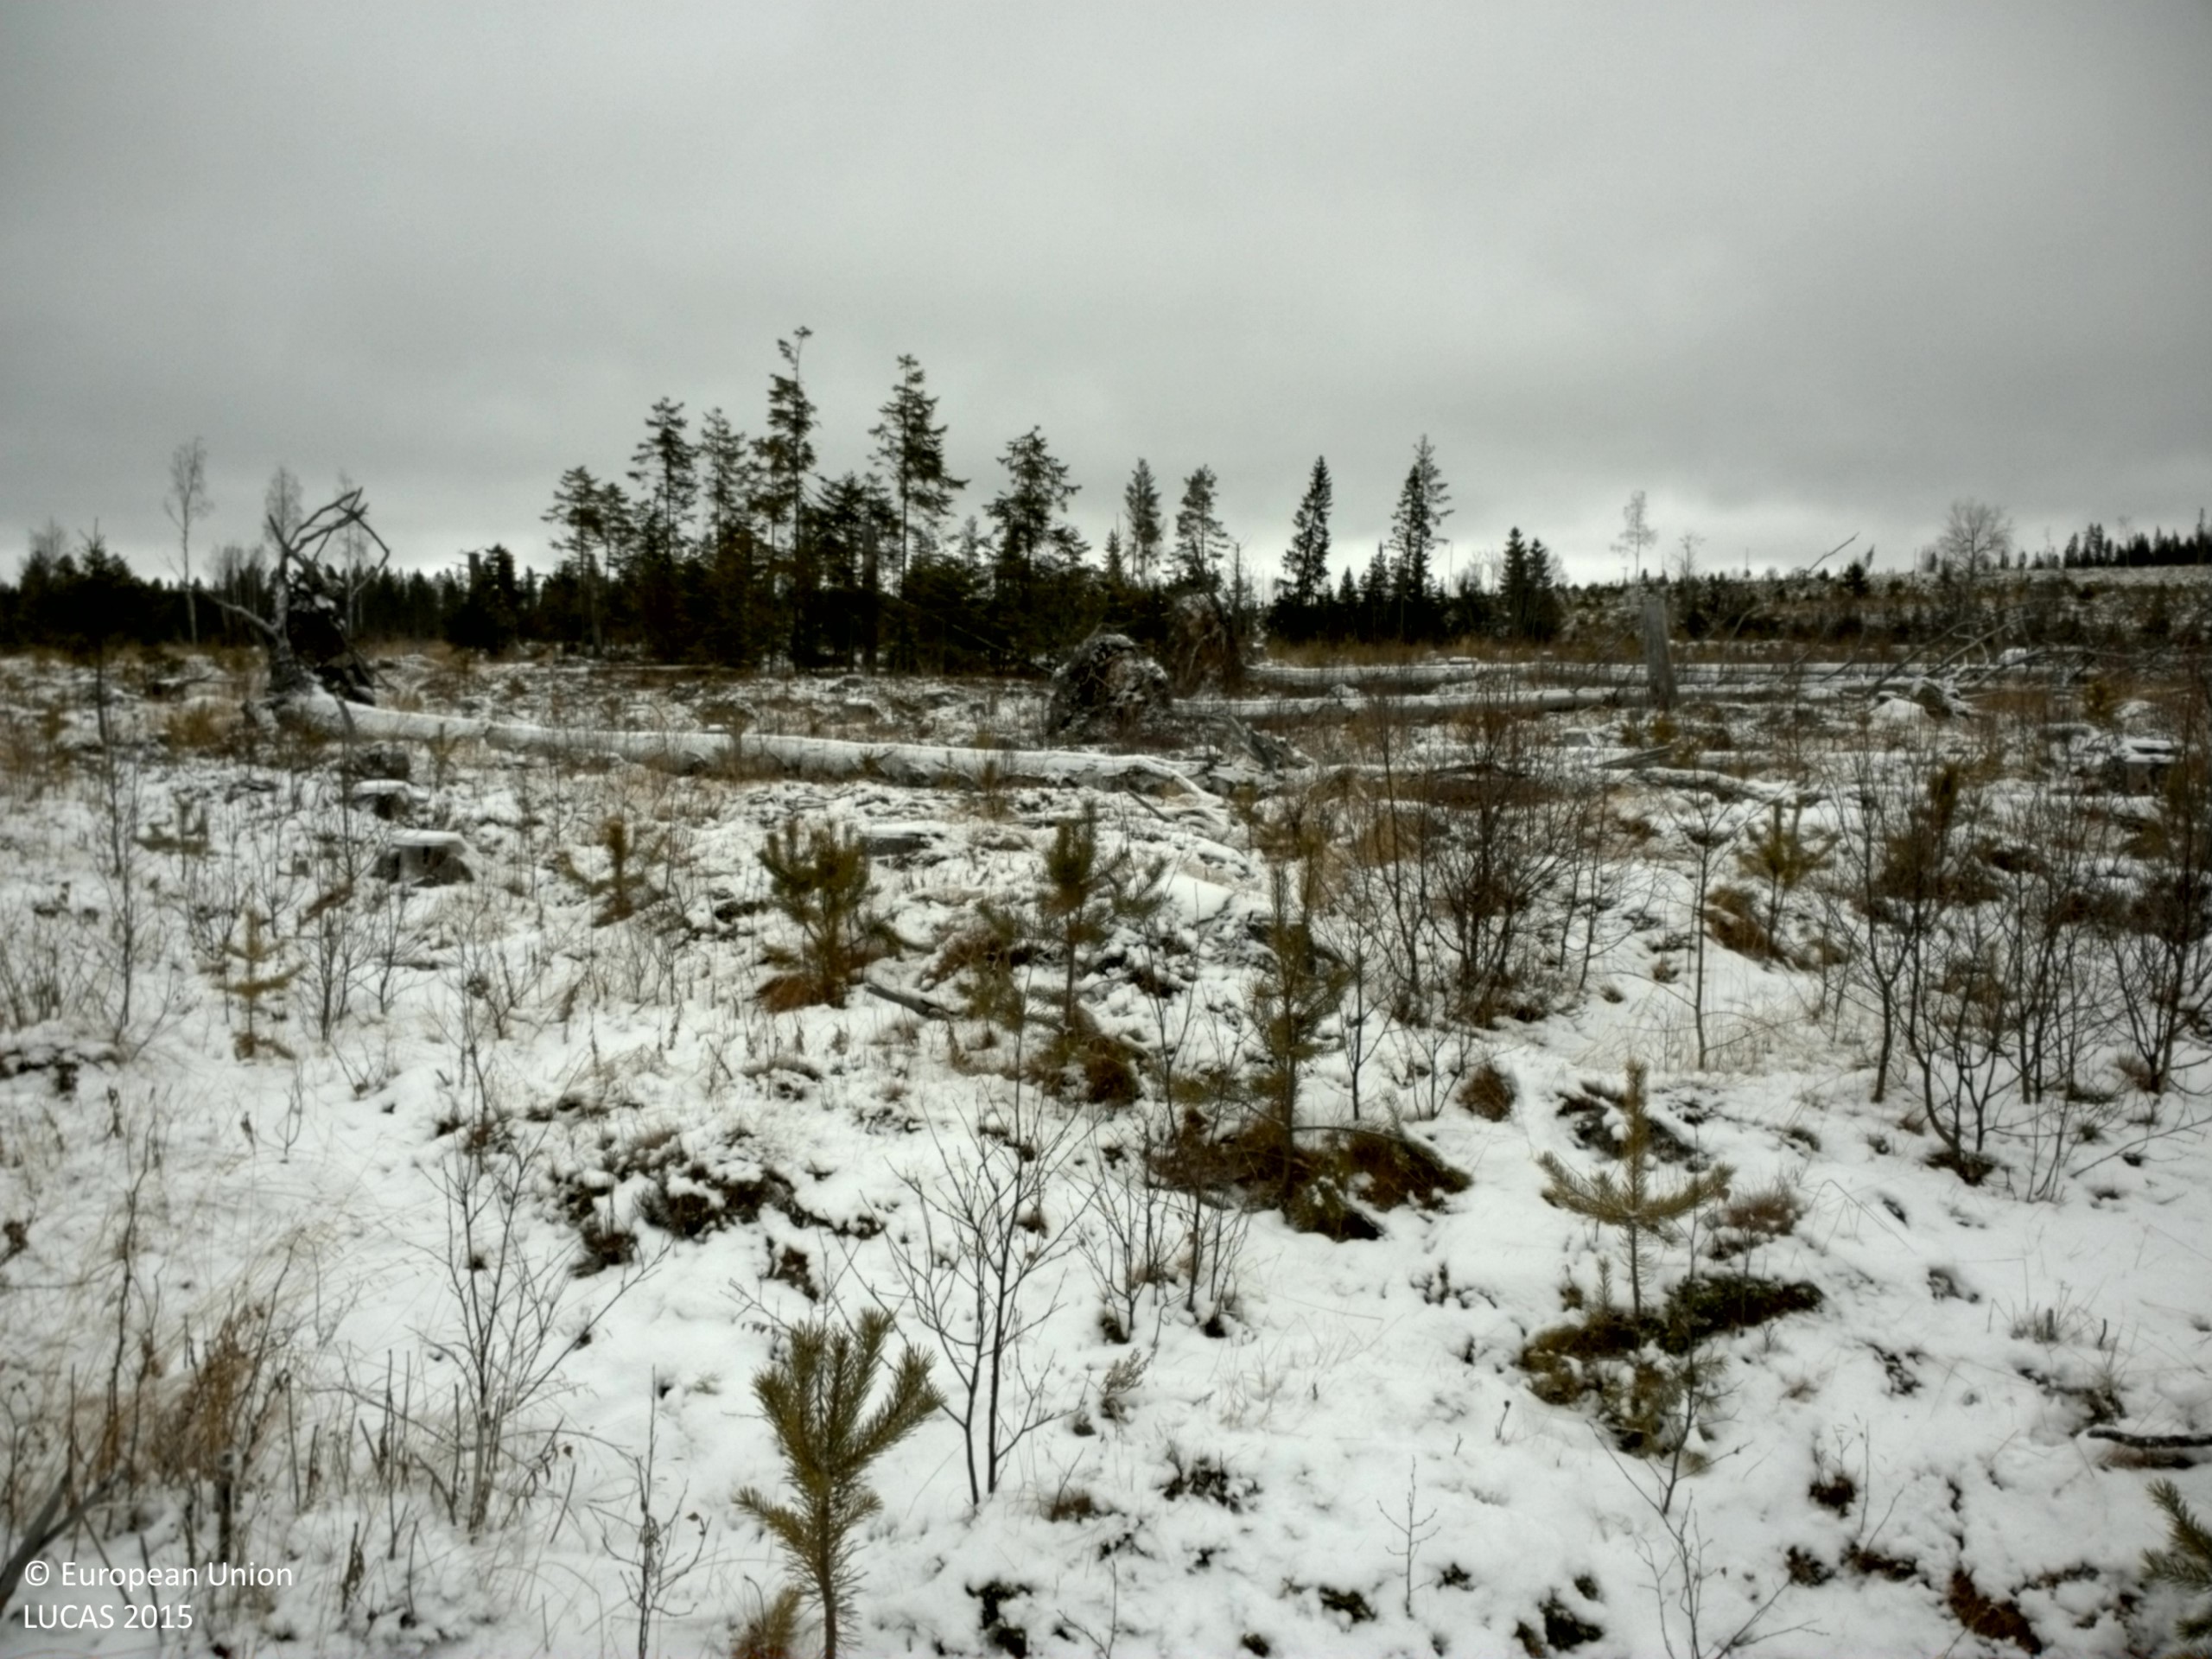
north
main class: Woodland
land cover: Pine dominated mixed woodland
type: boreal forest
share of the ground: 10 - 25 %
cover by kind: shrubs 50 %, lichens and mosses 25 %, coniferous forest trees 10 %, broadleaved forest trees 10 %, herbaceous plants 5 %
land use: Forestry
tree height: < 5 m
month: November
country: SE
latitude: 61.8235
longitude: 15.5449
